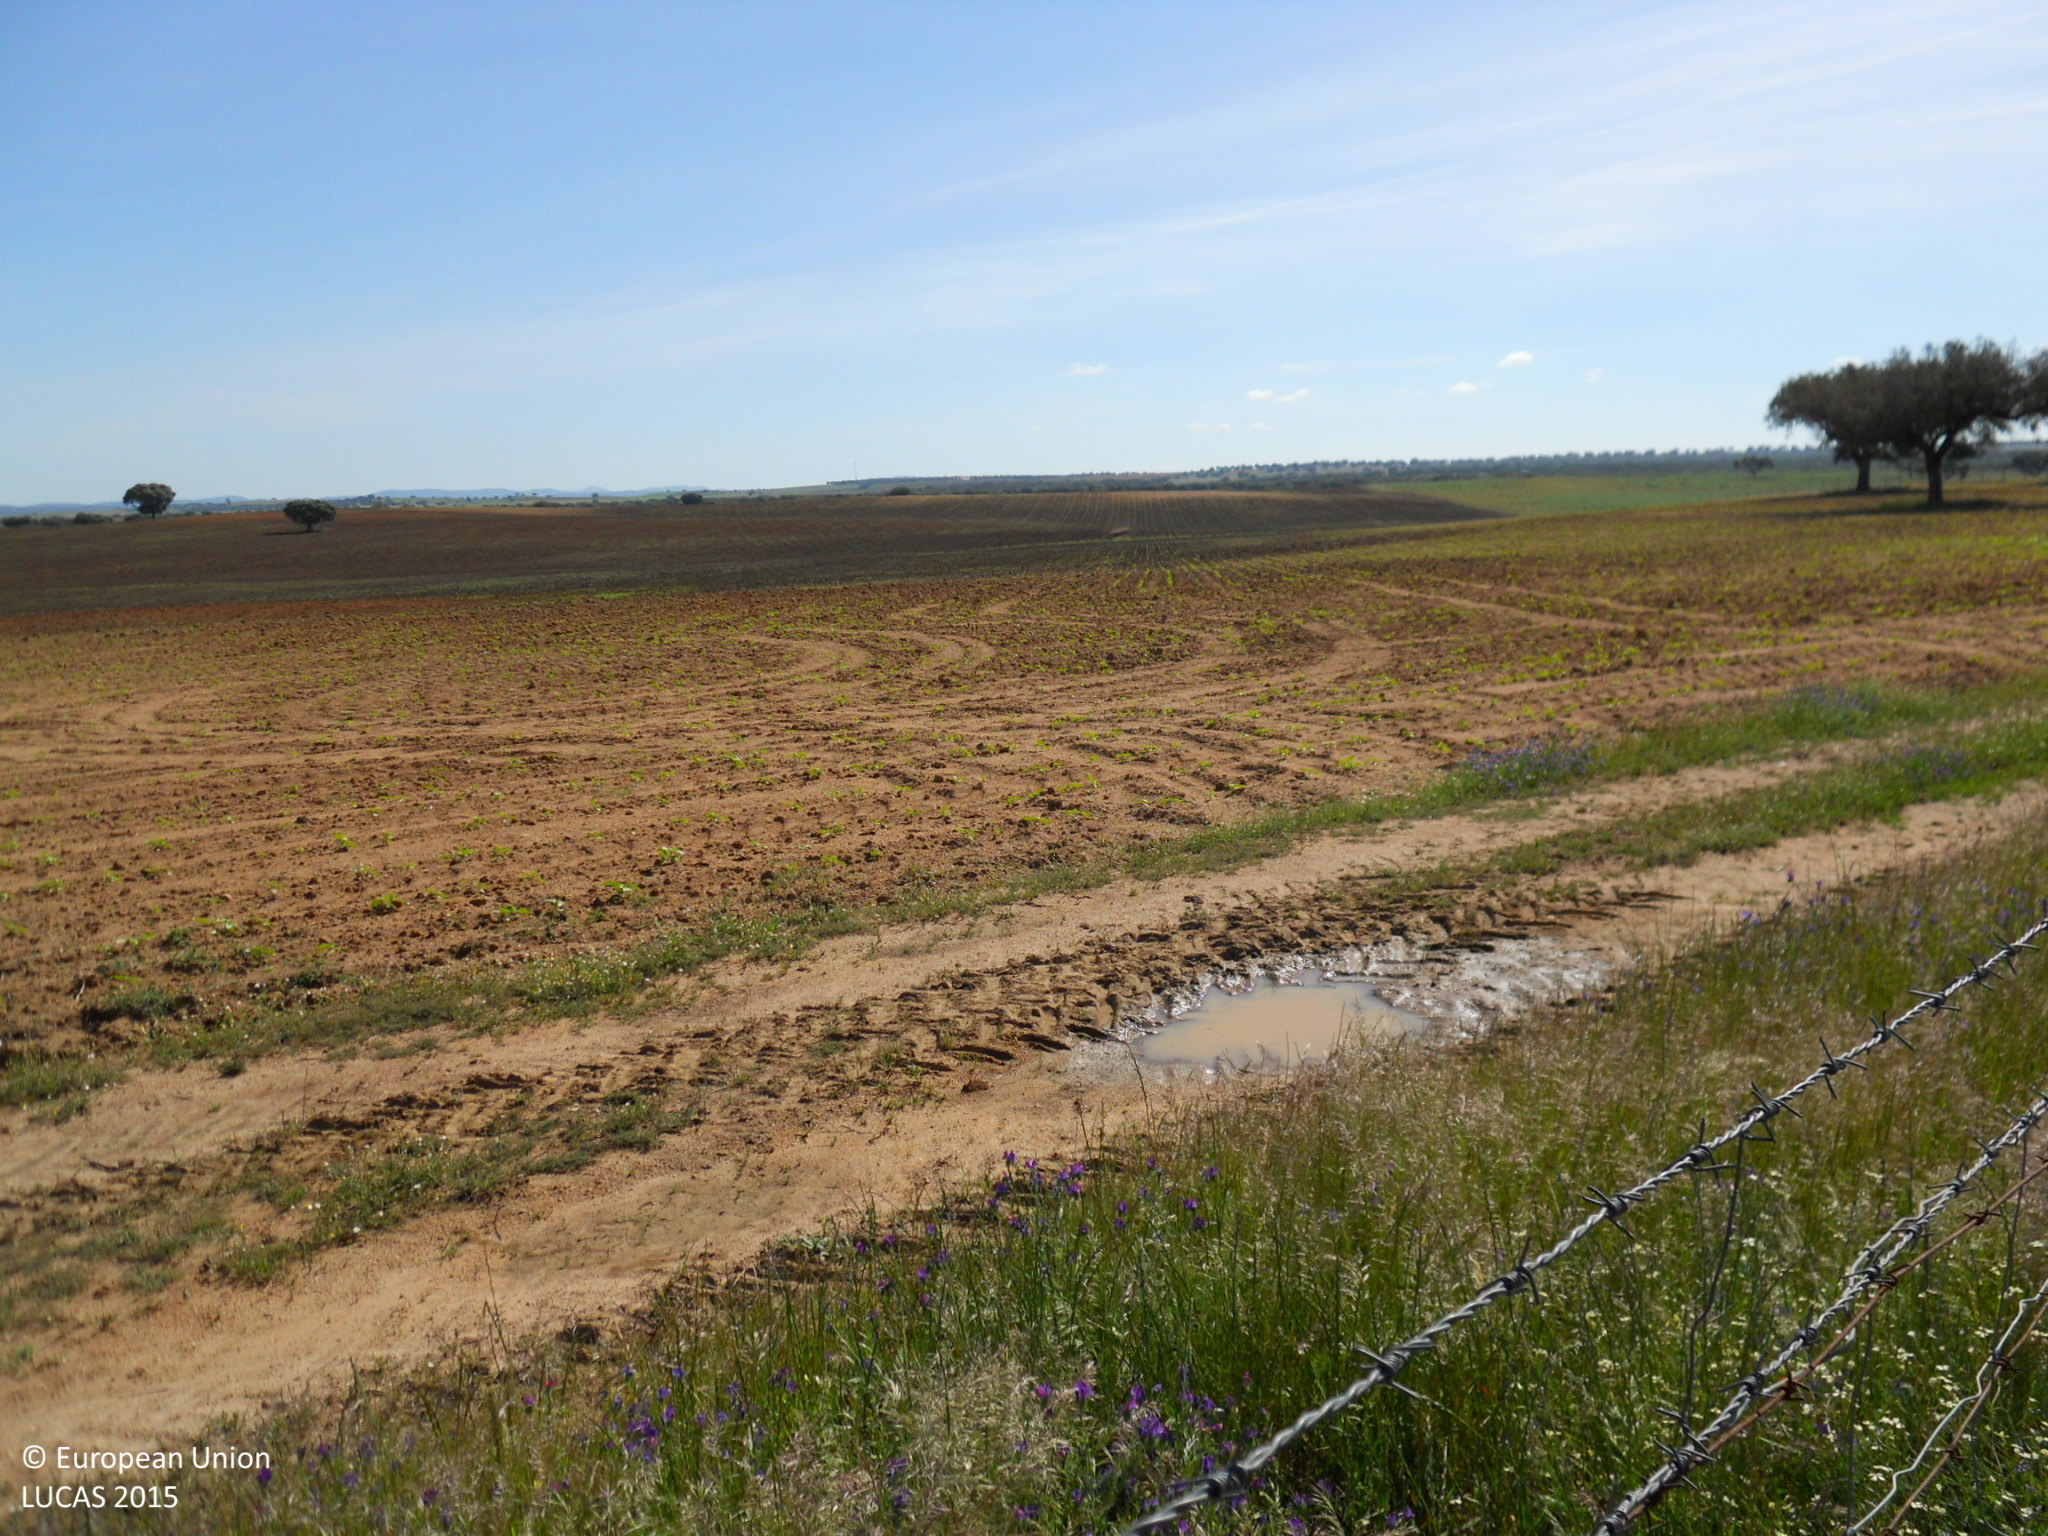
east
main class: Cropland
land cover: Sunflower
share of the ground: < 10 %
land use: Agriculture (excluding fallow land and kitchen gardens)
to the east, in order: Sunflower
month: April
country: ES
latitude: 39.0407
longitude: -6.8337
